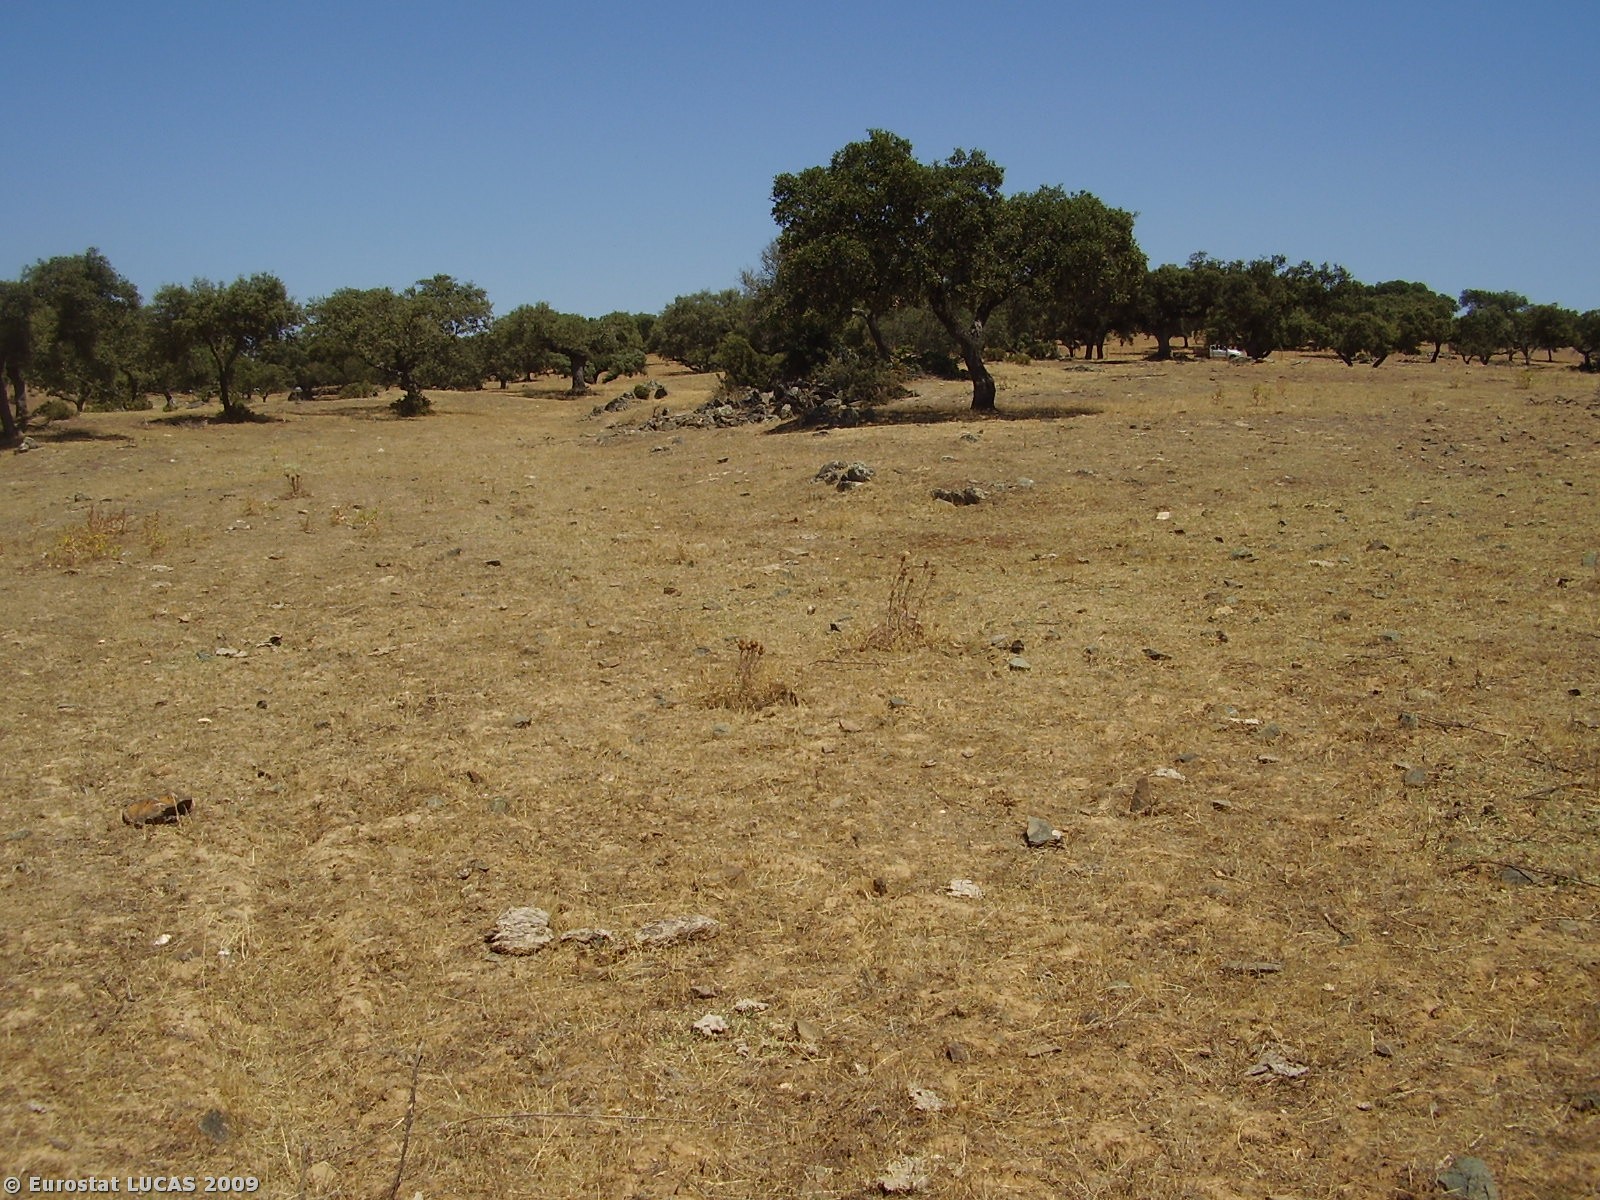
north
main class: Grassland
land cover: Grassland with sparse tree/shrub cover
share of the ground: > 75 %
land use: Fallow land
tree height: > 5 m
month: July
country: PT
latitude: 38.8285
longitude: -7.2969
